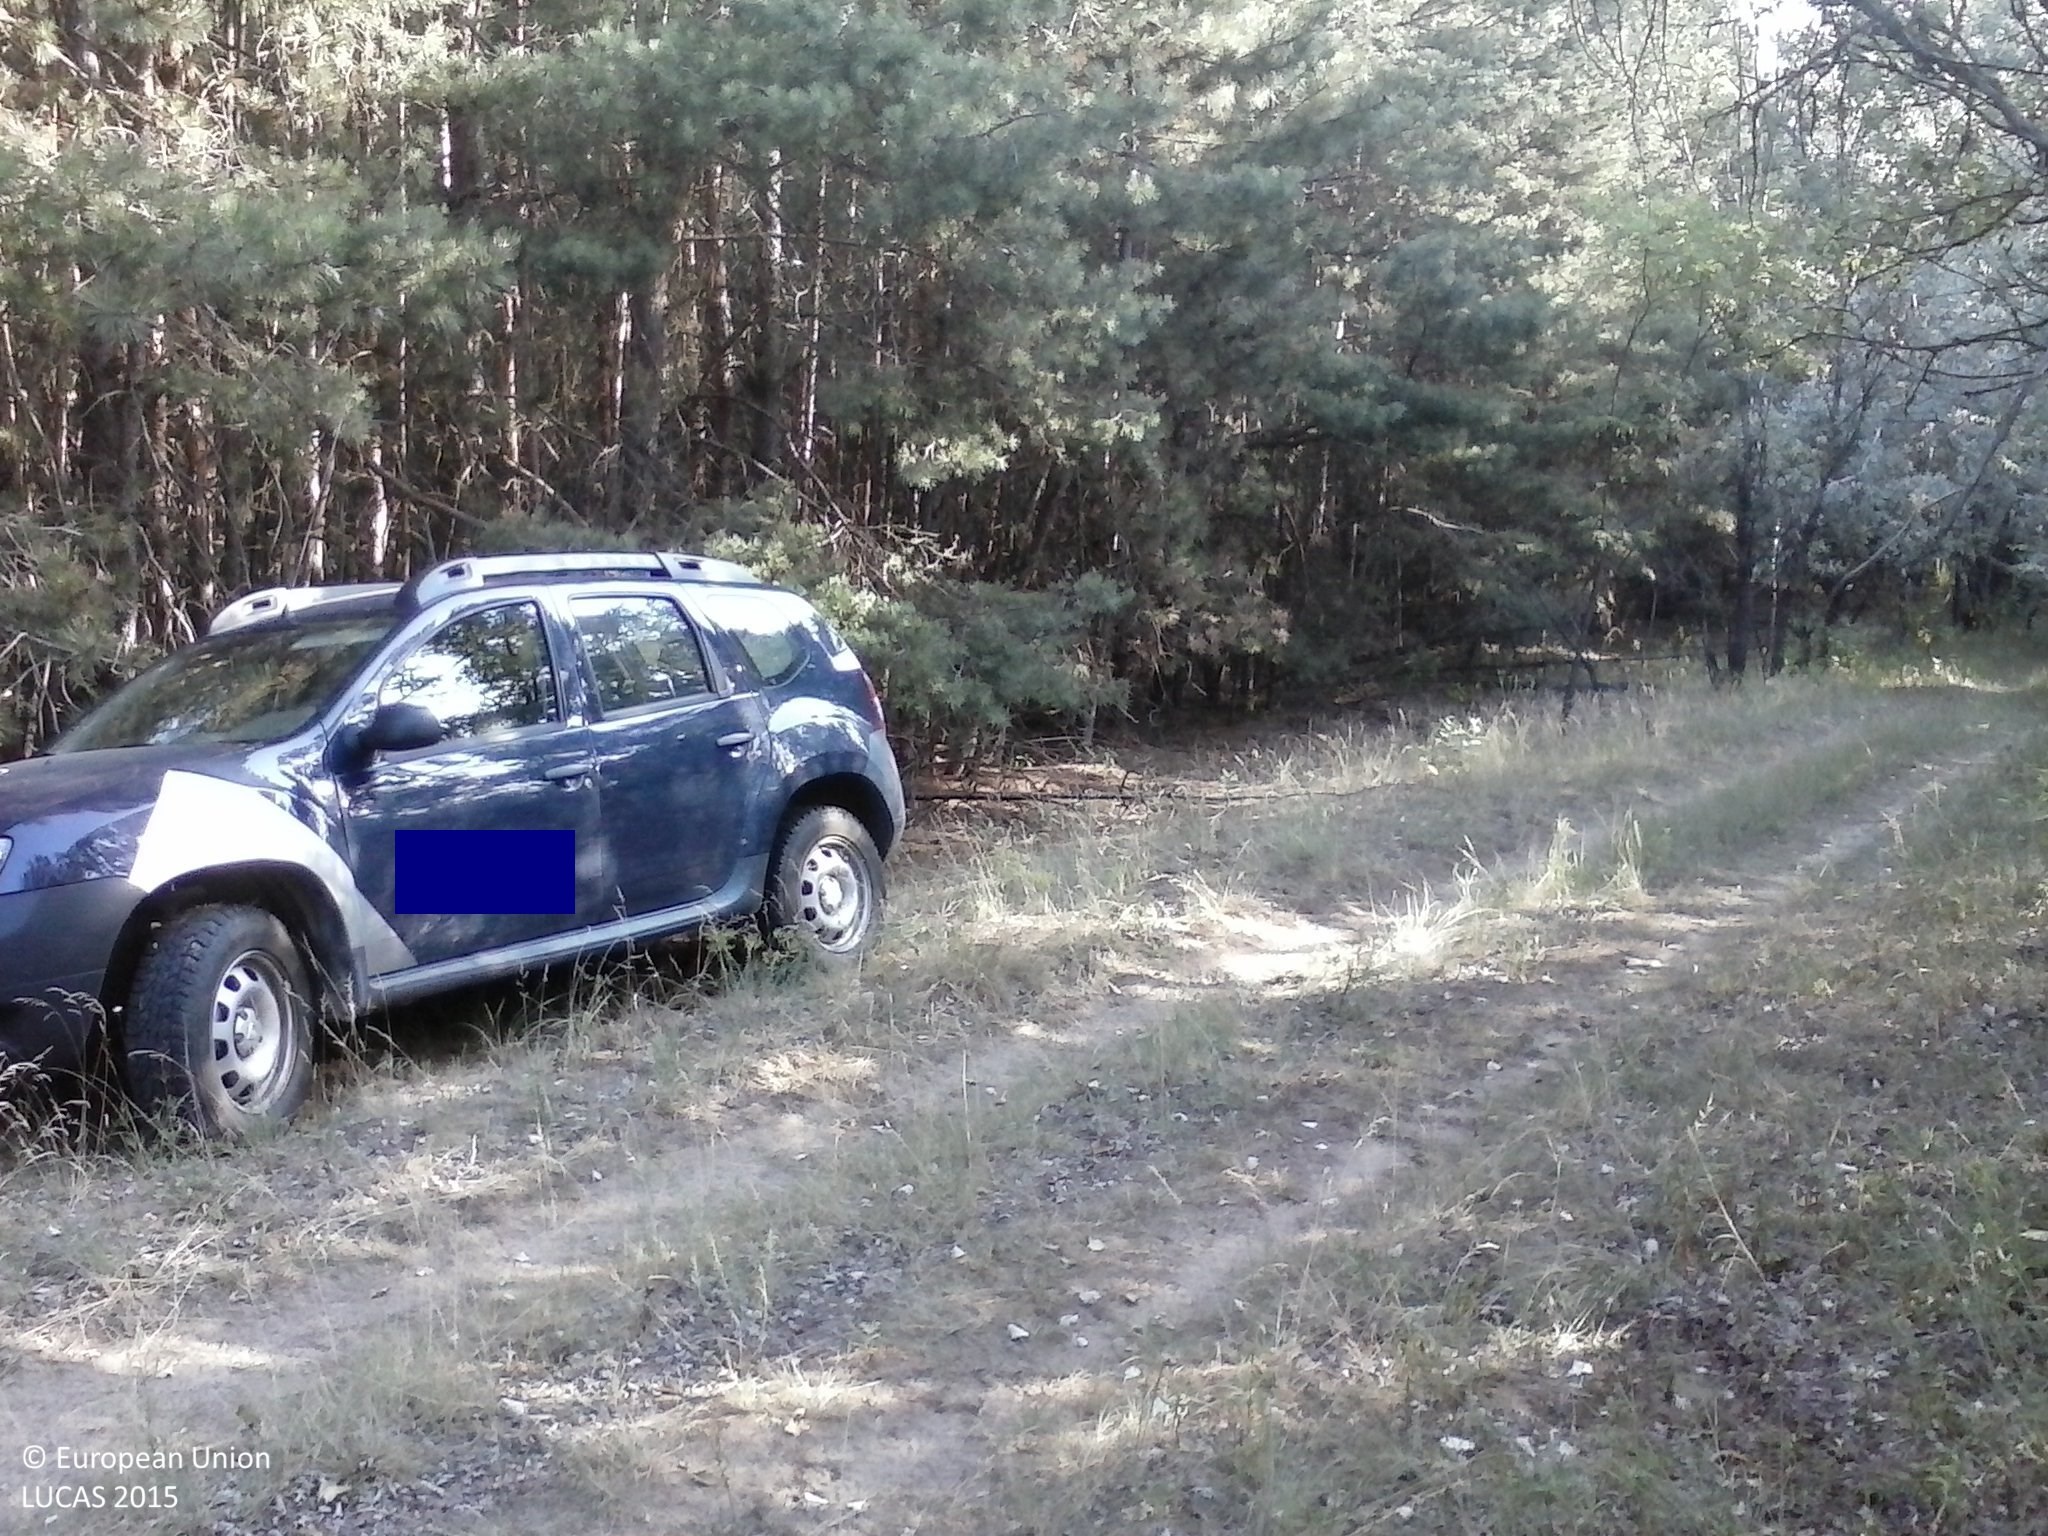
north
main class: Woodland
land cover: Broadleaved woodland
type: mesophytic deciduous forest
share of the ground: > 75 %
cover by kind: broadleaved forest trees 80 %, shrubs 10 %, herbaceous plants 10 %
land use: Forestry
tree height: > 5 m
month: July
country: HU
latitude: 46.4410
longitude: 19.6373
